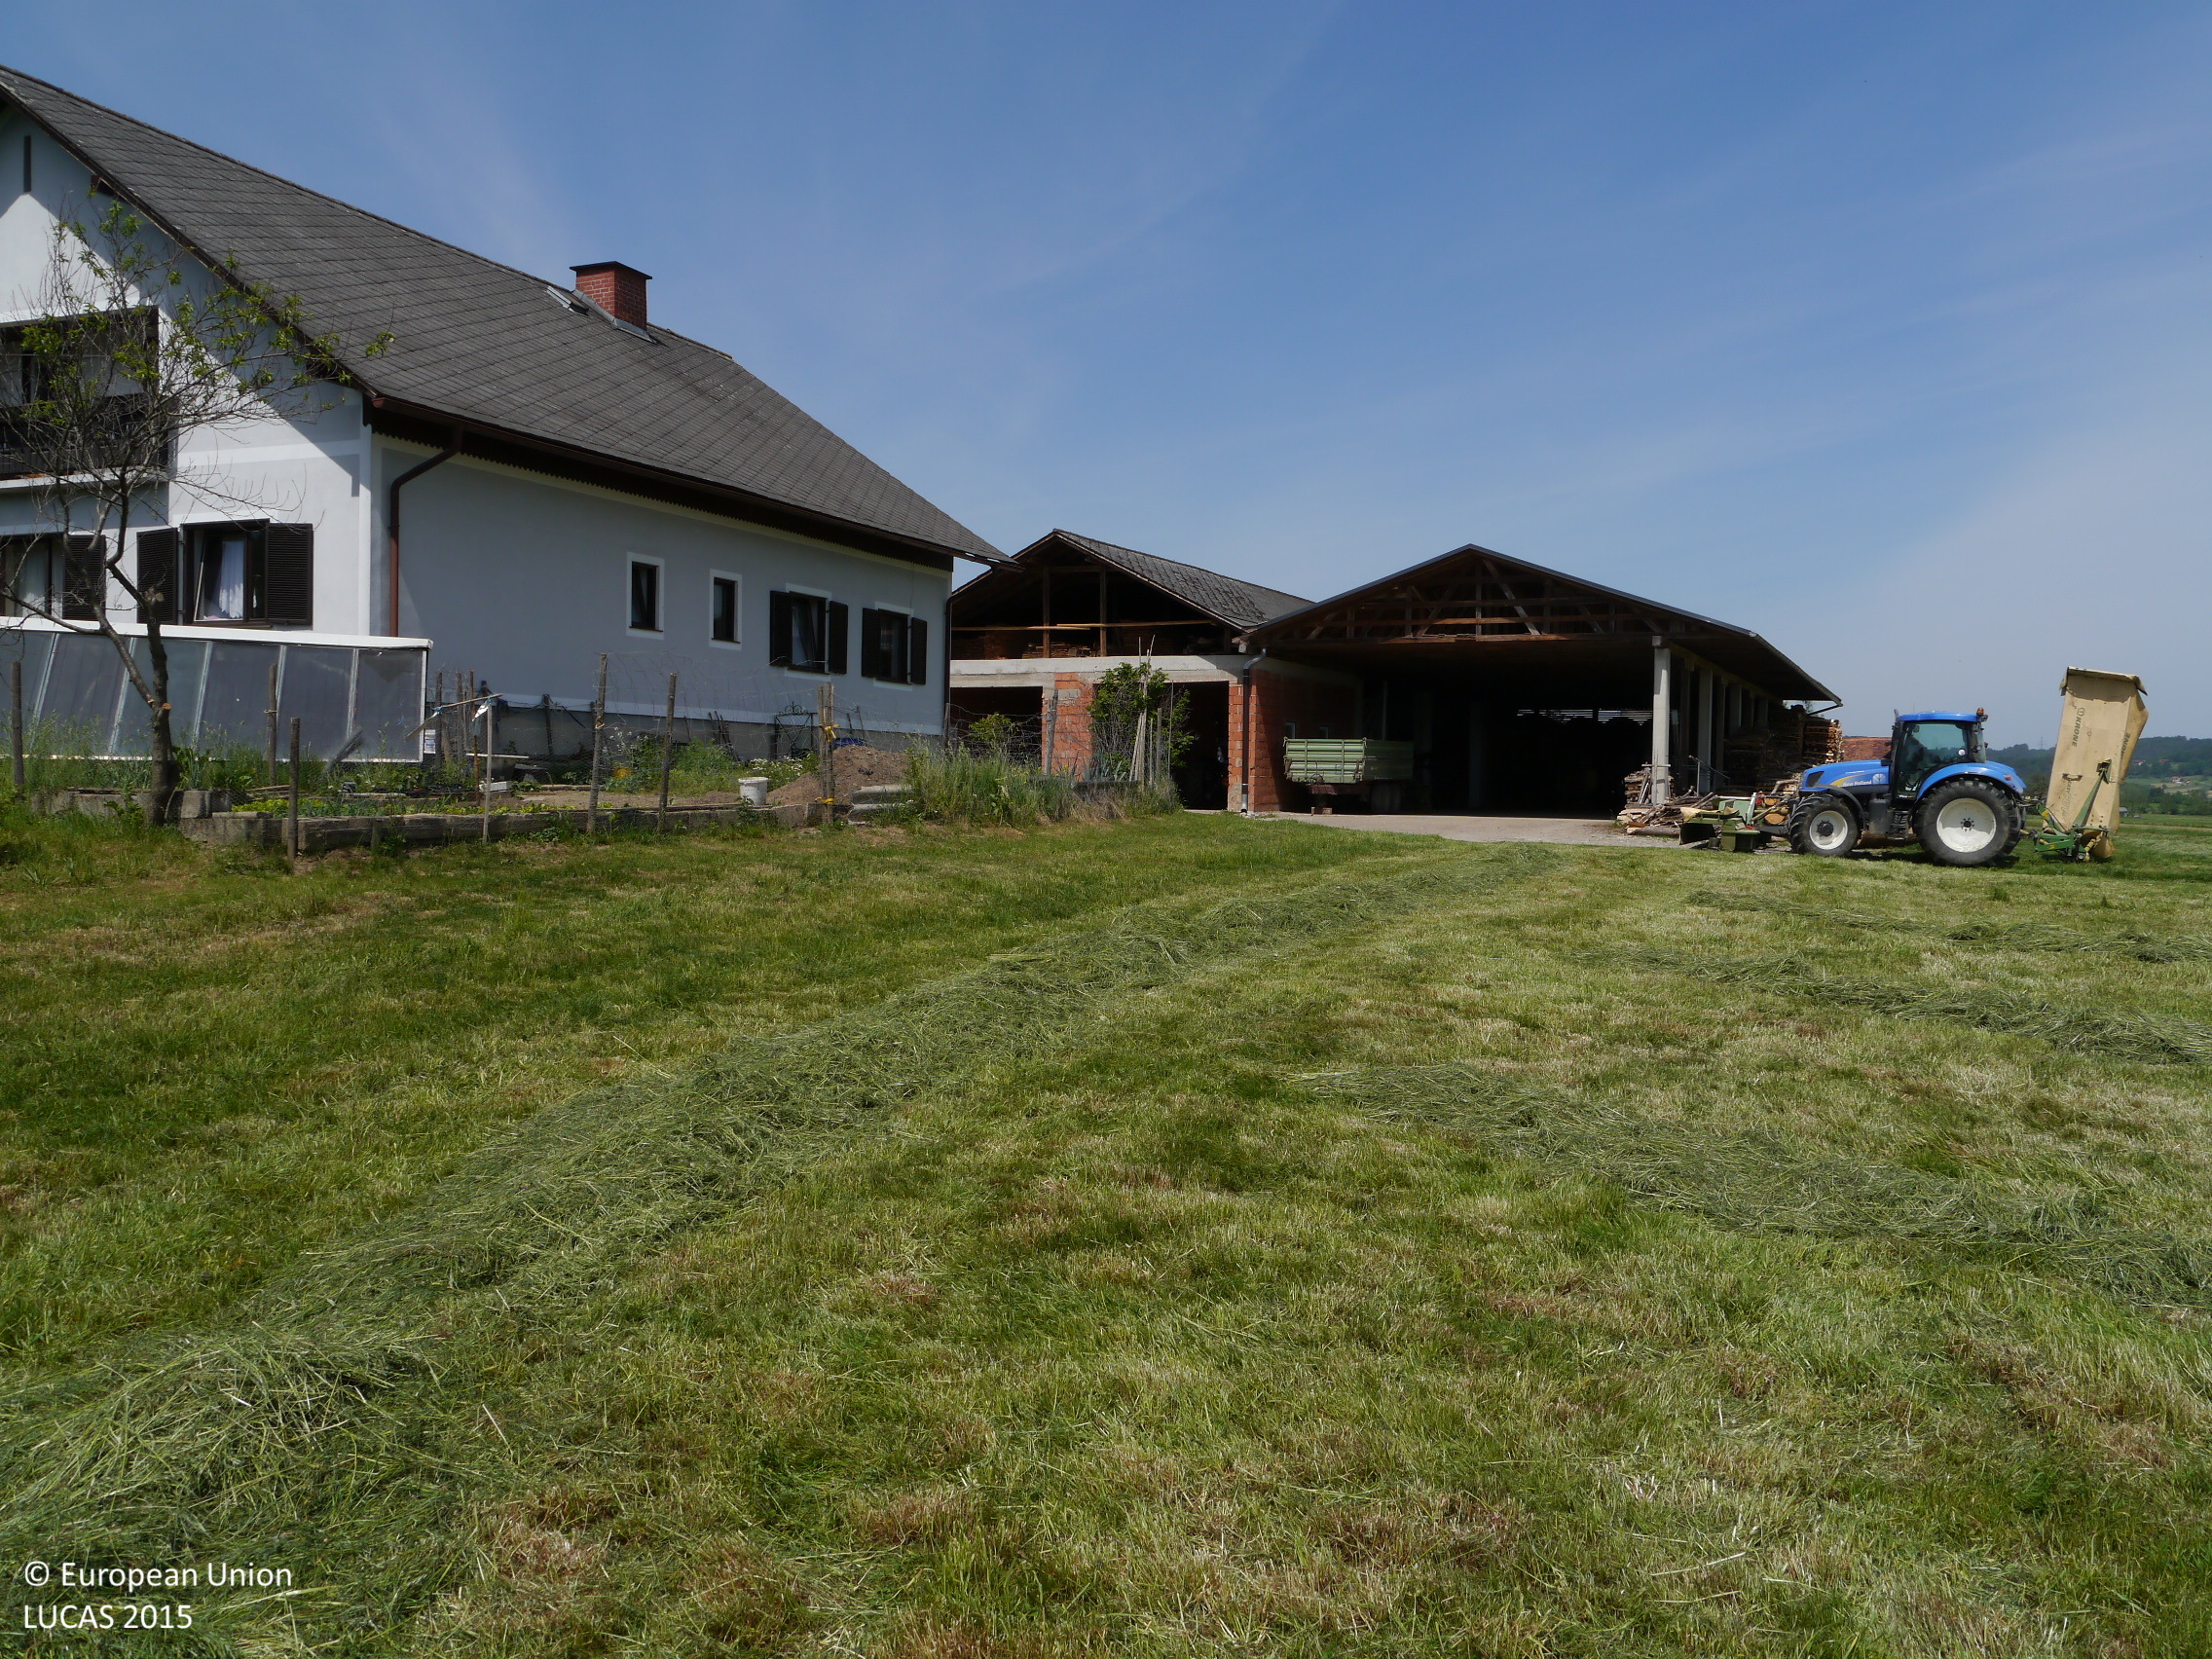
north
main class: Grassland
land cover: Grassland without tree/shrub cover
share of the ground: > 75 %
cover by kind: herbaceous plants 100 %
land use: Agriculture (excluding fallow land and kitchen gardens)
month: May
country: AT
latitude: 46.9813
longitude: 15.5873
